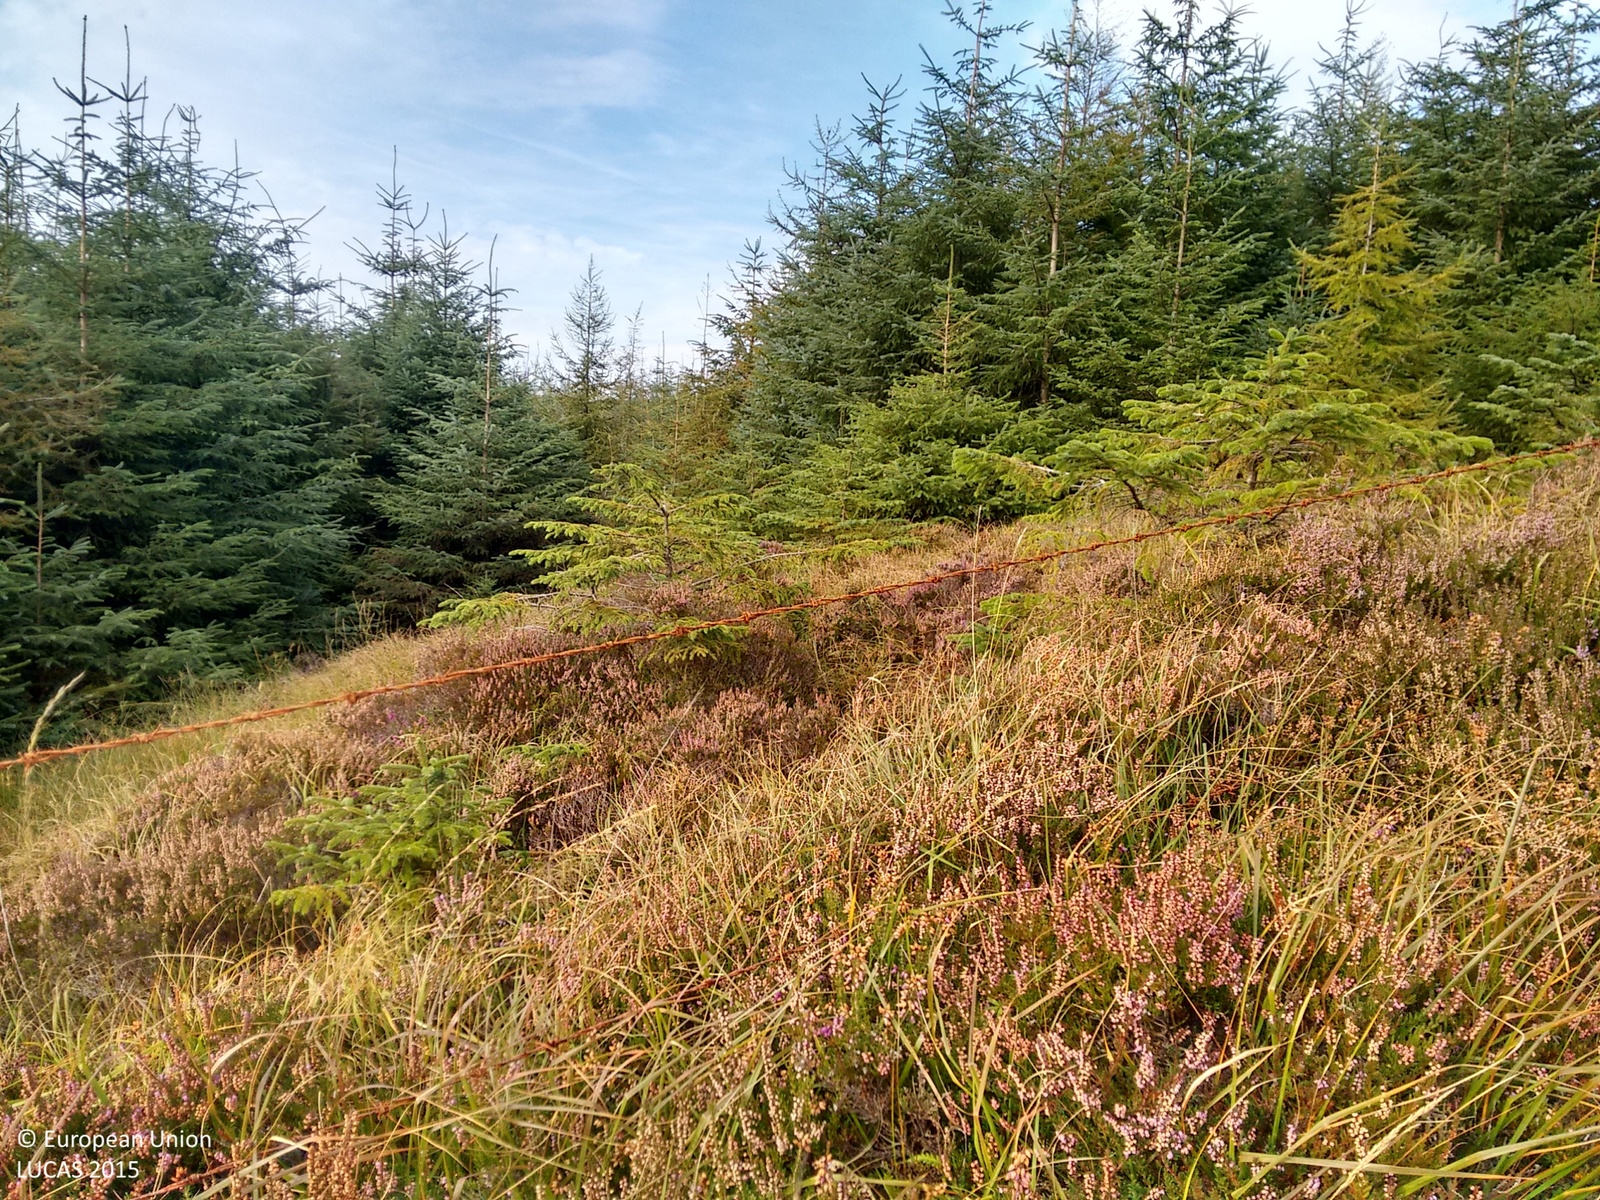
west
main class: Woodland
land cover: Spruce dominated coniferous woodland
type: exotic forest
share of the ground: > 75 %
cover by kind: coniferous forest trees 100 %
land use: Forestry
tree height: > 5 m
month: September
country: IE
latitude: 52.9451
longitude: -9.2568
